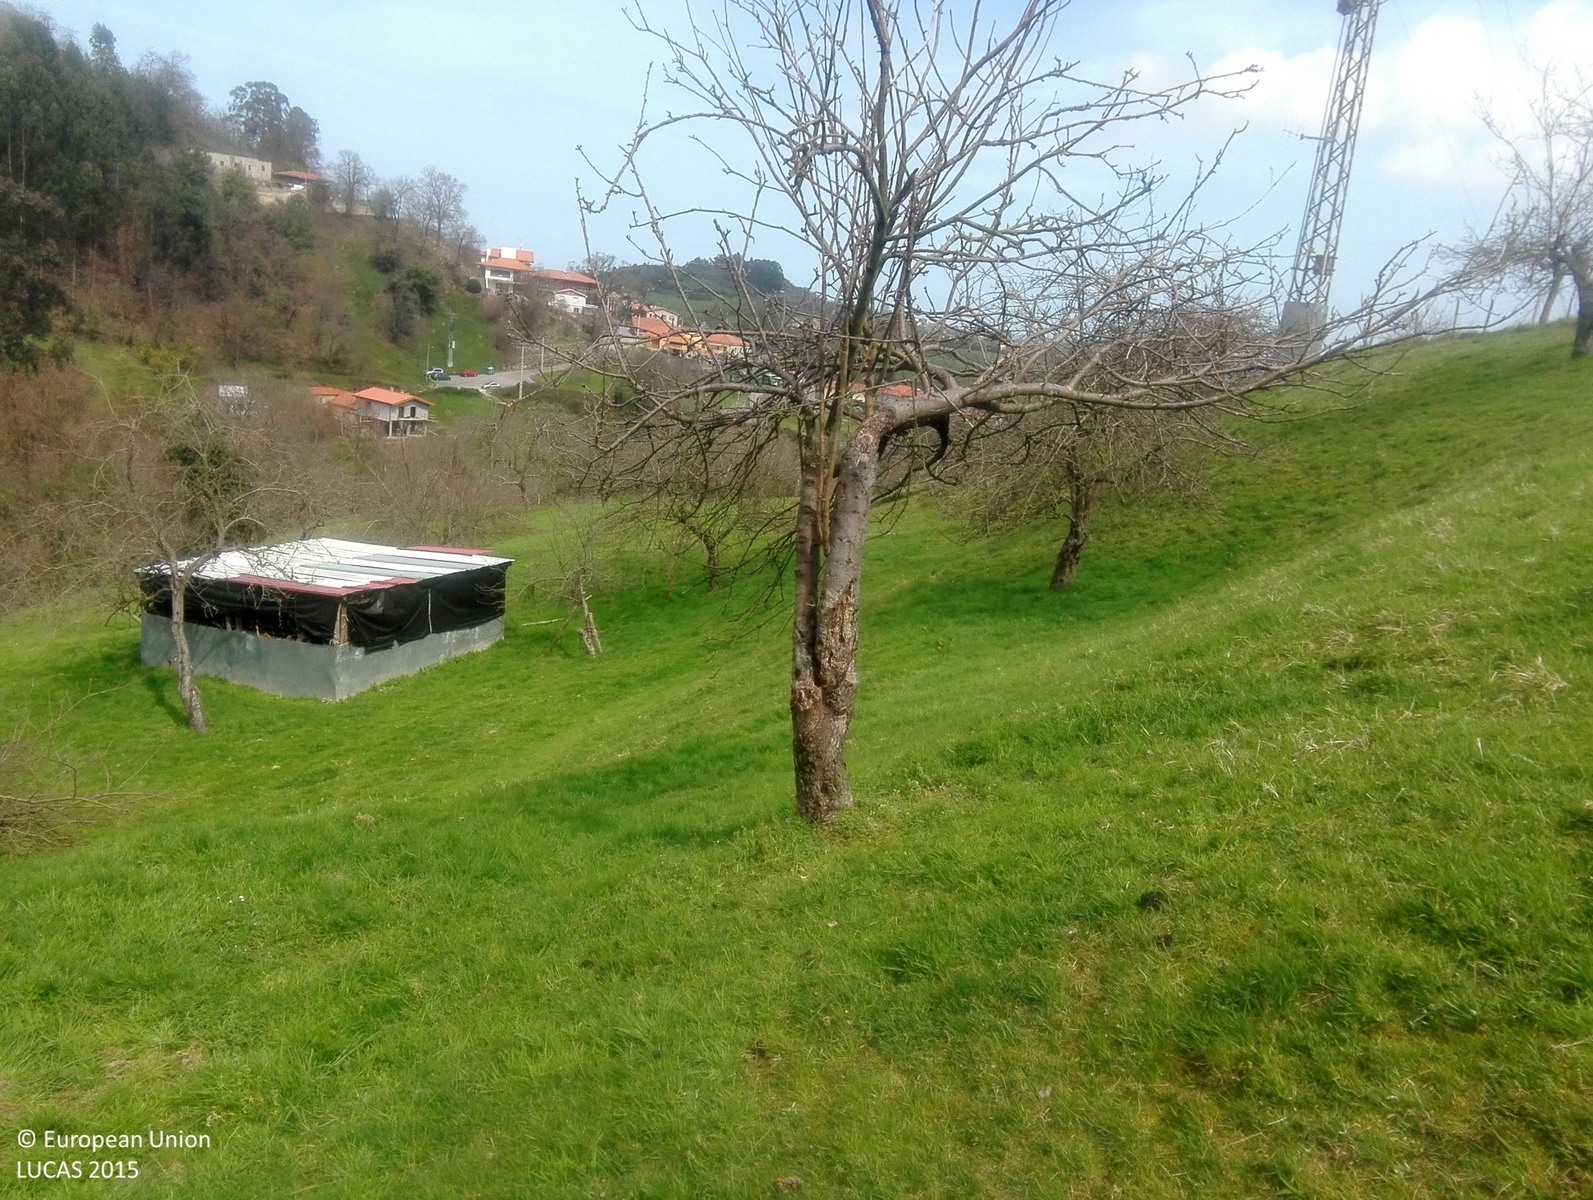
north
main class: Cropland
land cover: Apple fruit
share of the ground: 50 - 75 %
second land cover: Grassland without tree/shrub cover
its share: > 75 %
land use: Agriculture (excluding fallow land and kitchen gardens)
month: April
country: ES
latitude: 43.4667
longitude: -5.6465
